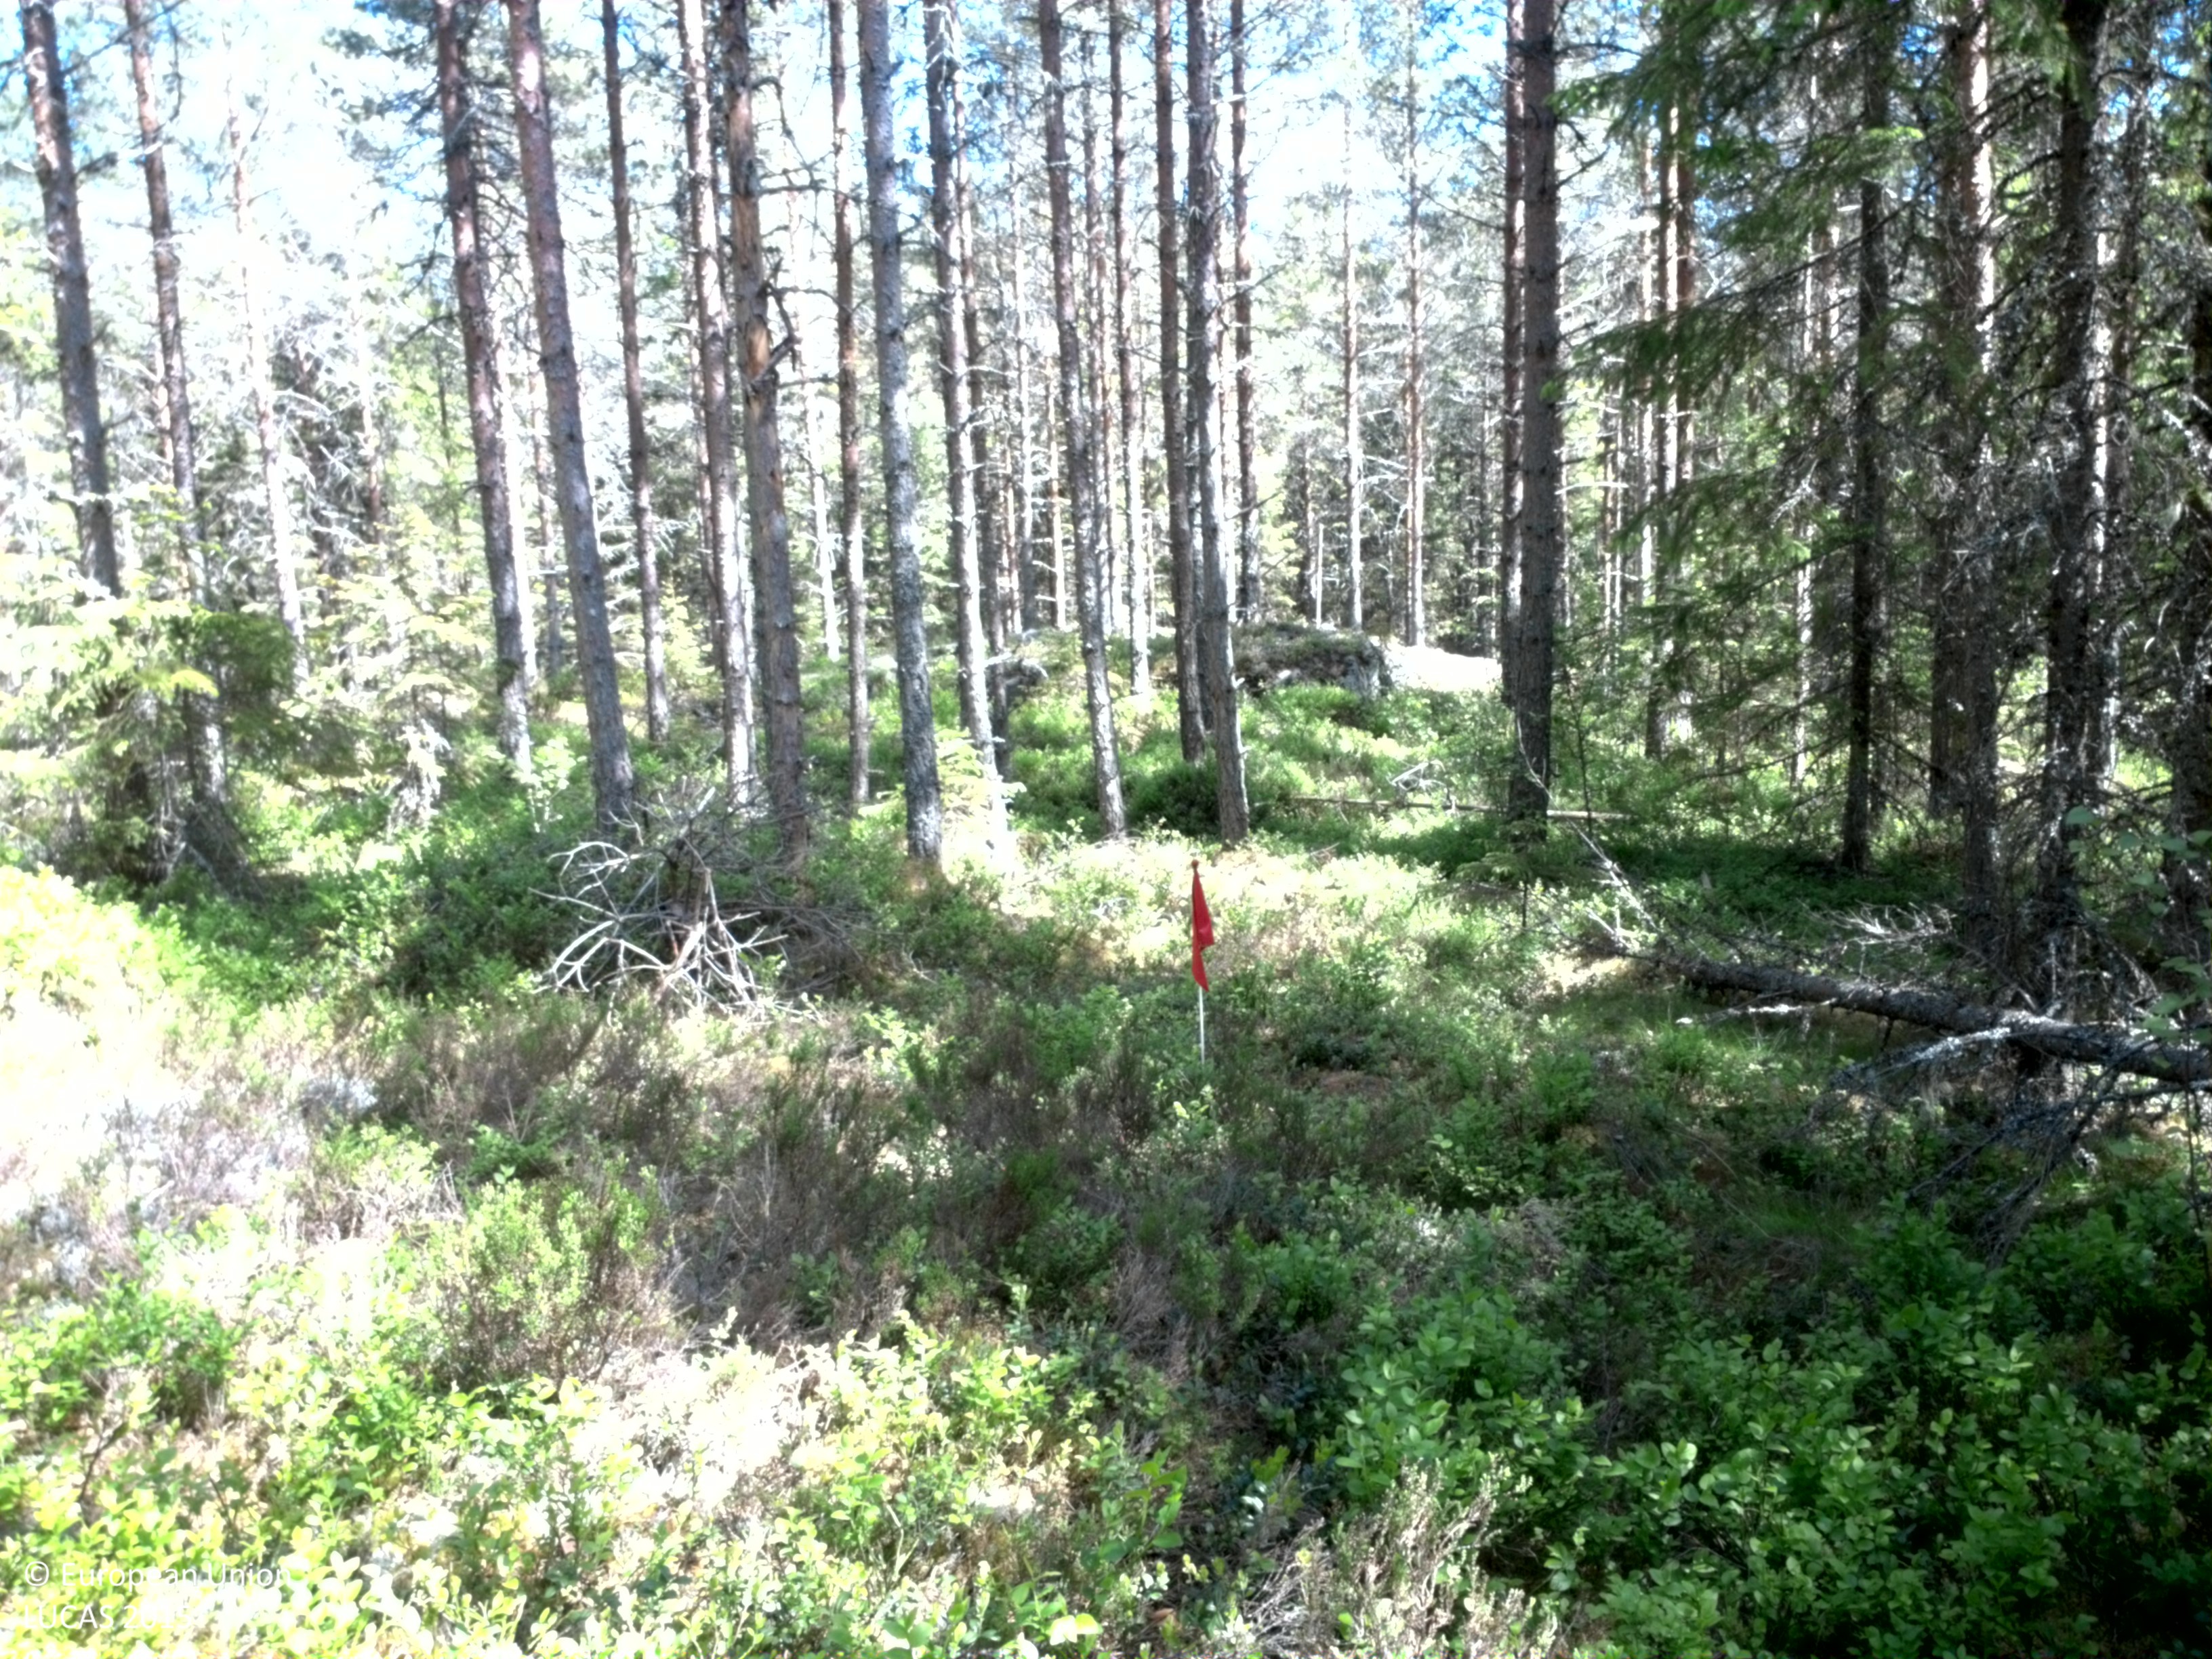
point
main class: Woodland
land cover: Pine dominated coniferous woodland
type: boreal forest
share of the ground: > 75 %
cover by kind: coniferous forest trees 75 %, shrubs 15 %, broadleaved forest trees 5 %, herbaceous plants 5 %
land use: Forestry
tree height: > 5 m
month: June
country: SE
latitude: 59.5893
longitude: 12.0667
